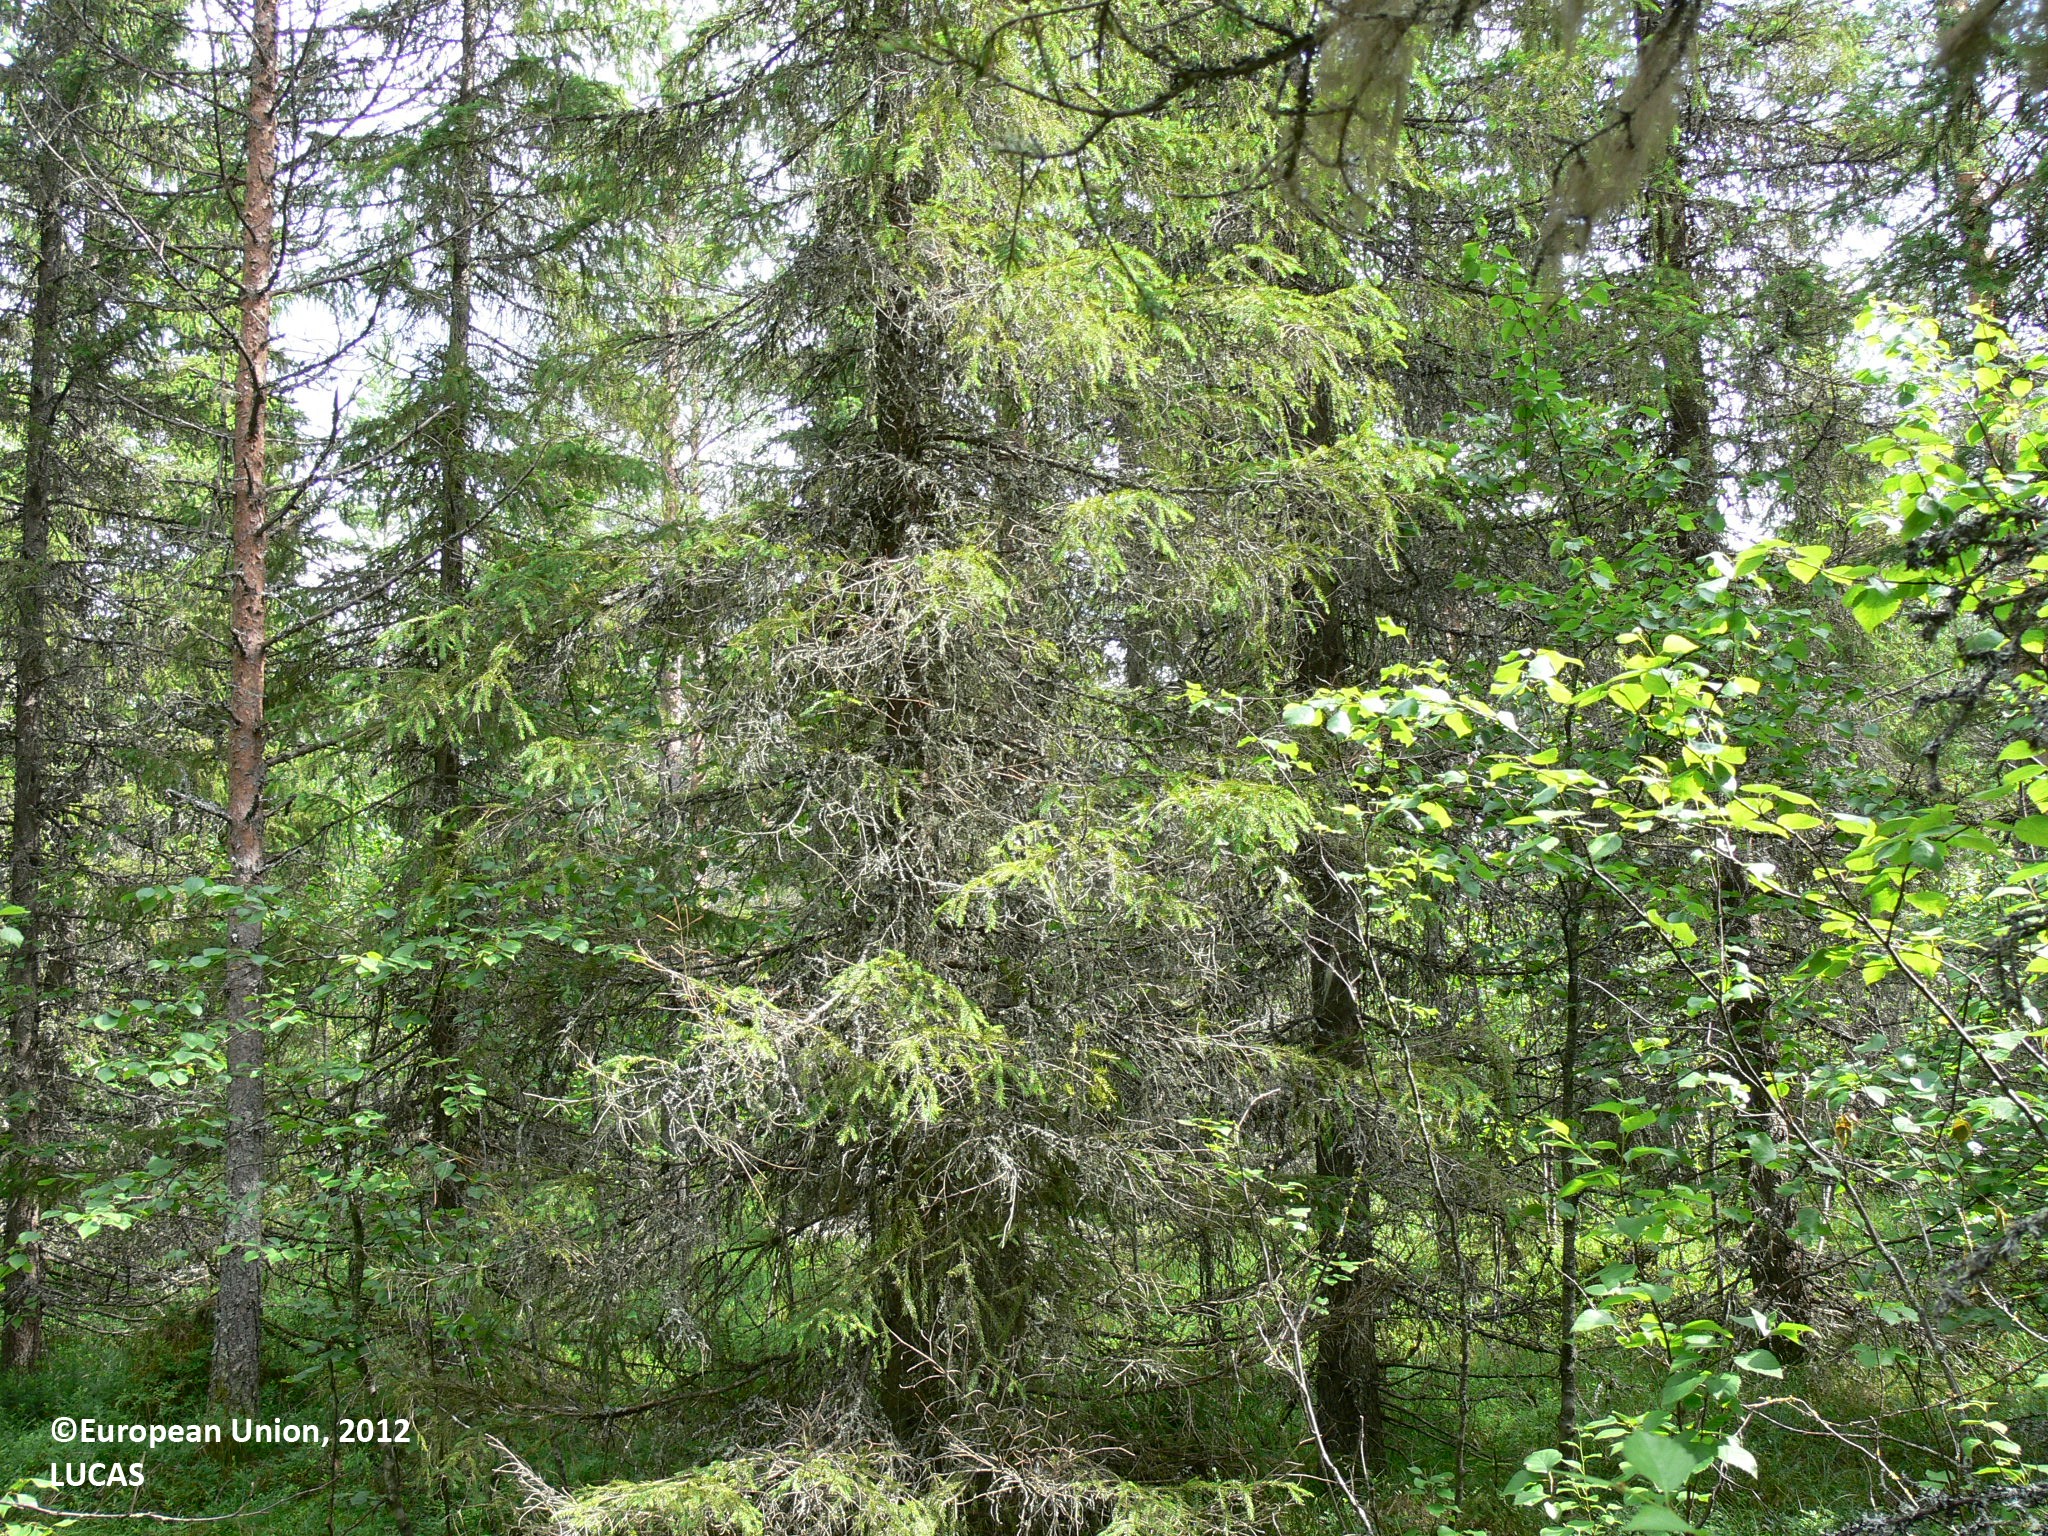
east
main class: Woodland
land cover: Other coniferous woodland
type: boreal forest
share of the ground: 50 - 75 %
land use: Forestry
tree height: > 5 m
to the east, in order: Other coniferous woodland; Ditches and canals; Pine dominated coniferous woodland; Ditches and canals; Pine dominated coniferous woodland; Other coniferous woodland; Ditches and canals; Other mixed woodland; Ditches and canals; Pine dominated coniferous woodland; Pine dominated mixed woodland
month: July
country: FI
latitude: 63.1480
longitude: 31.1616
